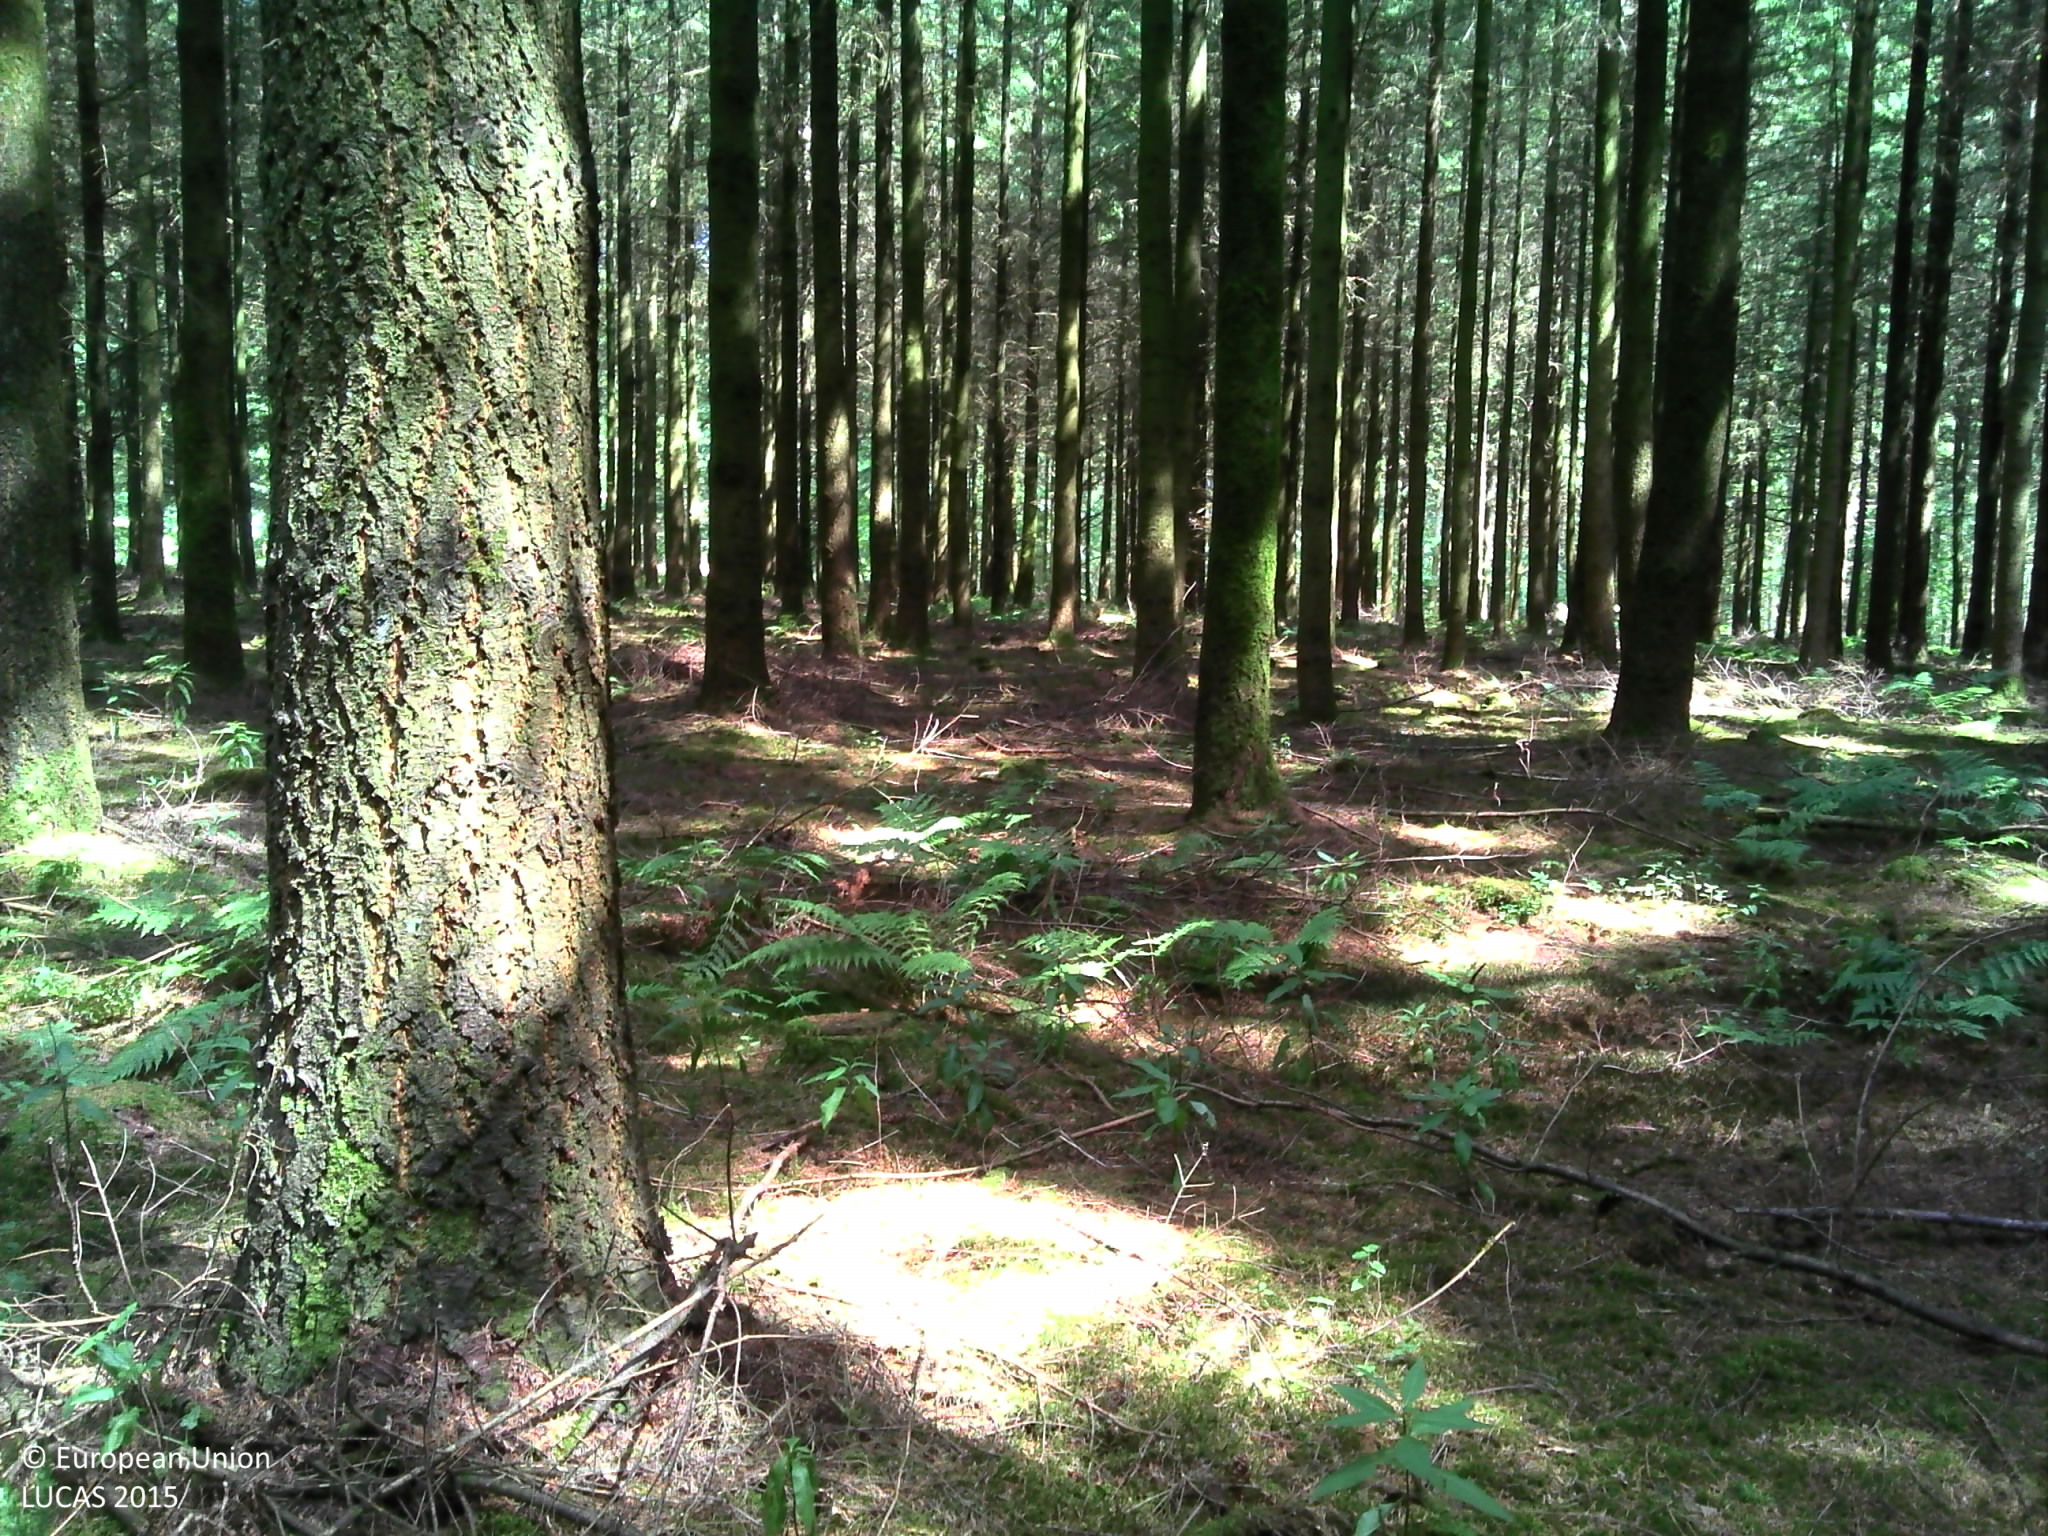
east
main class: Woodland
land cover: Other coniferous woodland
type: exotic forest
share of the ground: > 75 %
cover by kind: coniferous forest trees 95 %, herbaceous plants 5 %
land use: Forestry
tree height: > 5 m
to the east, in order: Other coniferous woodland; Broadleaved woodland; Tracks; Broadleaved woodland; Other coniferous woodland; Grass margins; Paved roads, cycling and walking lanes; Grass margins
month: July
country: BE
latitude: 49.8880
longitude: 5.7257
